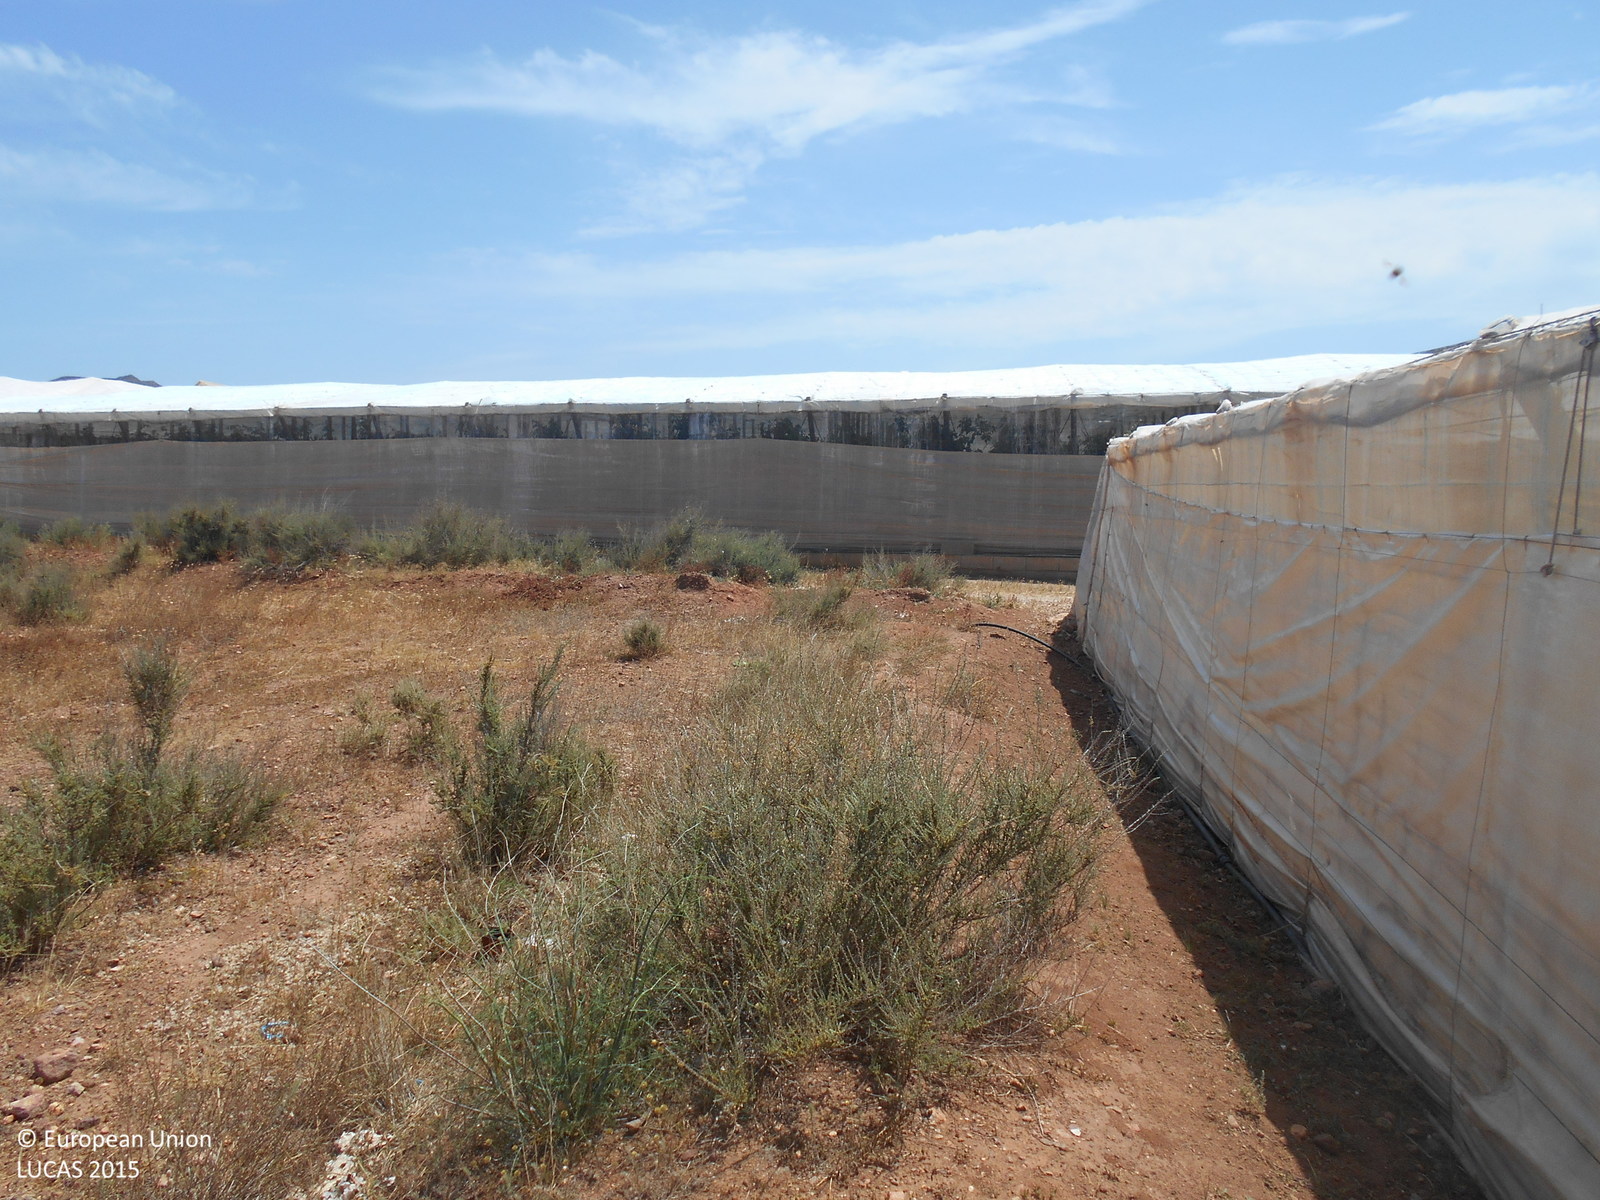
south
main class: Artificial land
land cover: Greenhouses
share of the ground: > 75 %
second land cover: Tomatoes
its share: 25 - 50 %
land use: Agriculture (excluding fallow land and kitchen gardens)
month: May
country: ES
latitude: 36.7911
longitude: -2.2216
